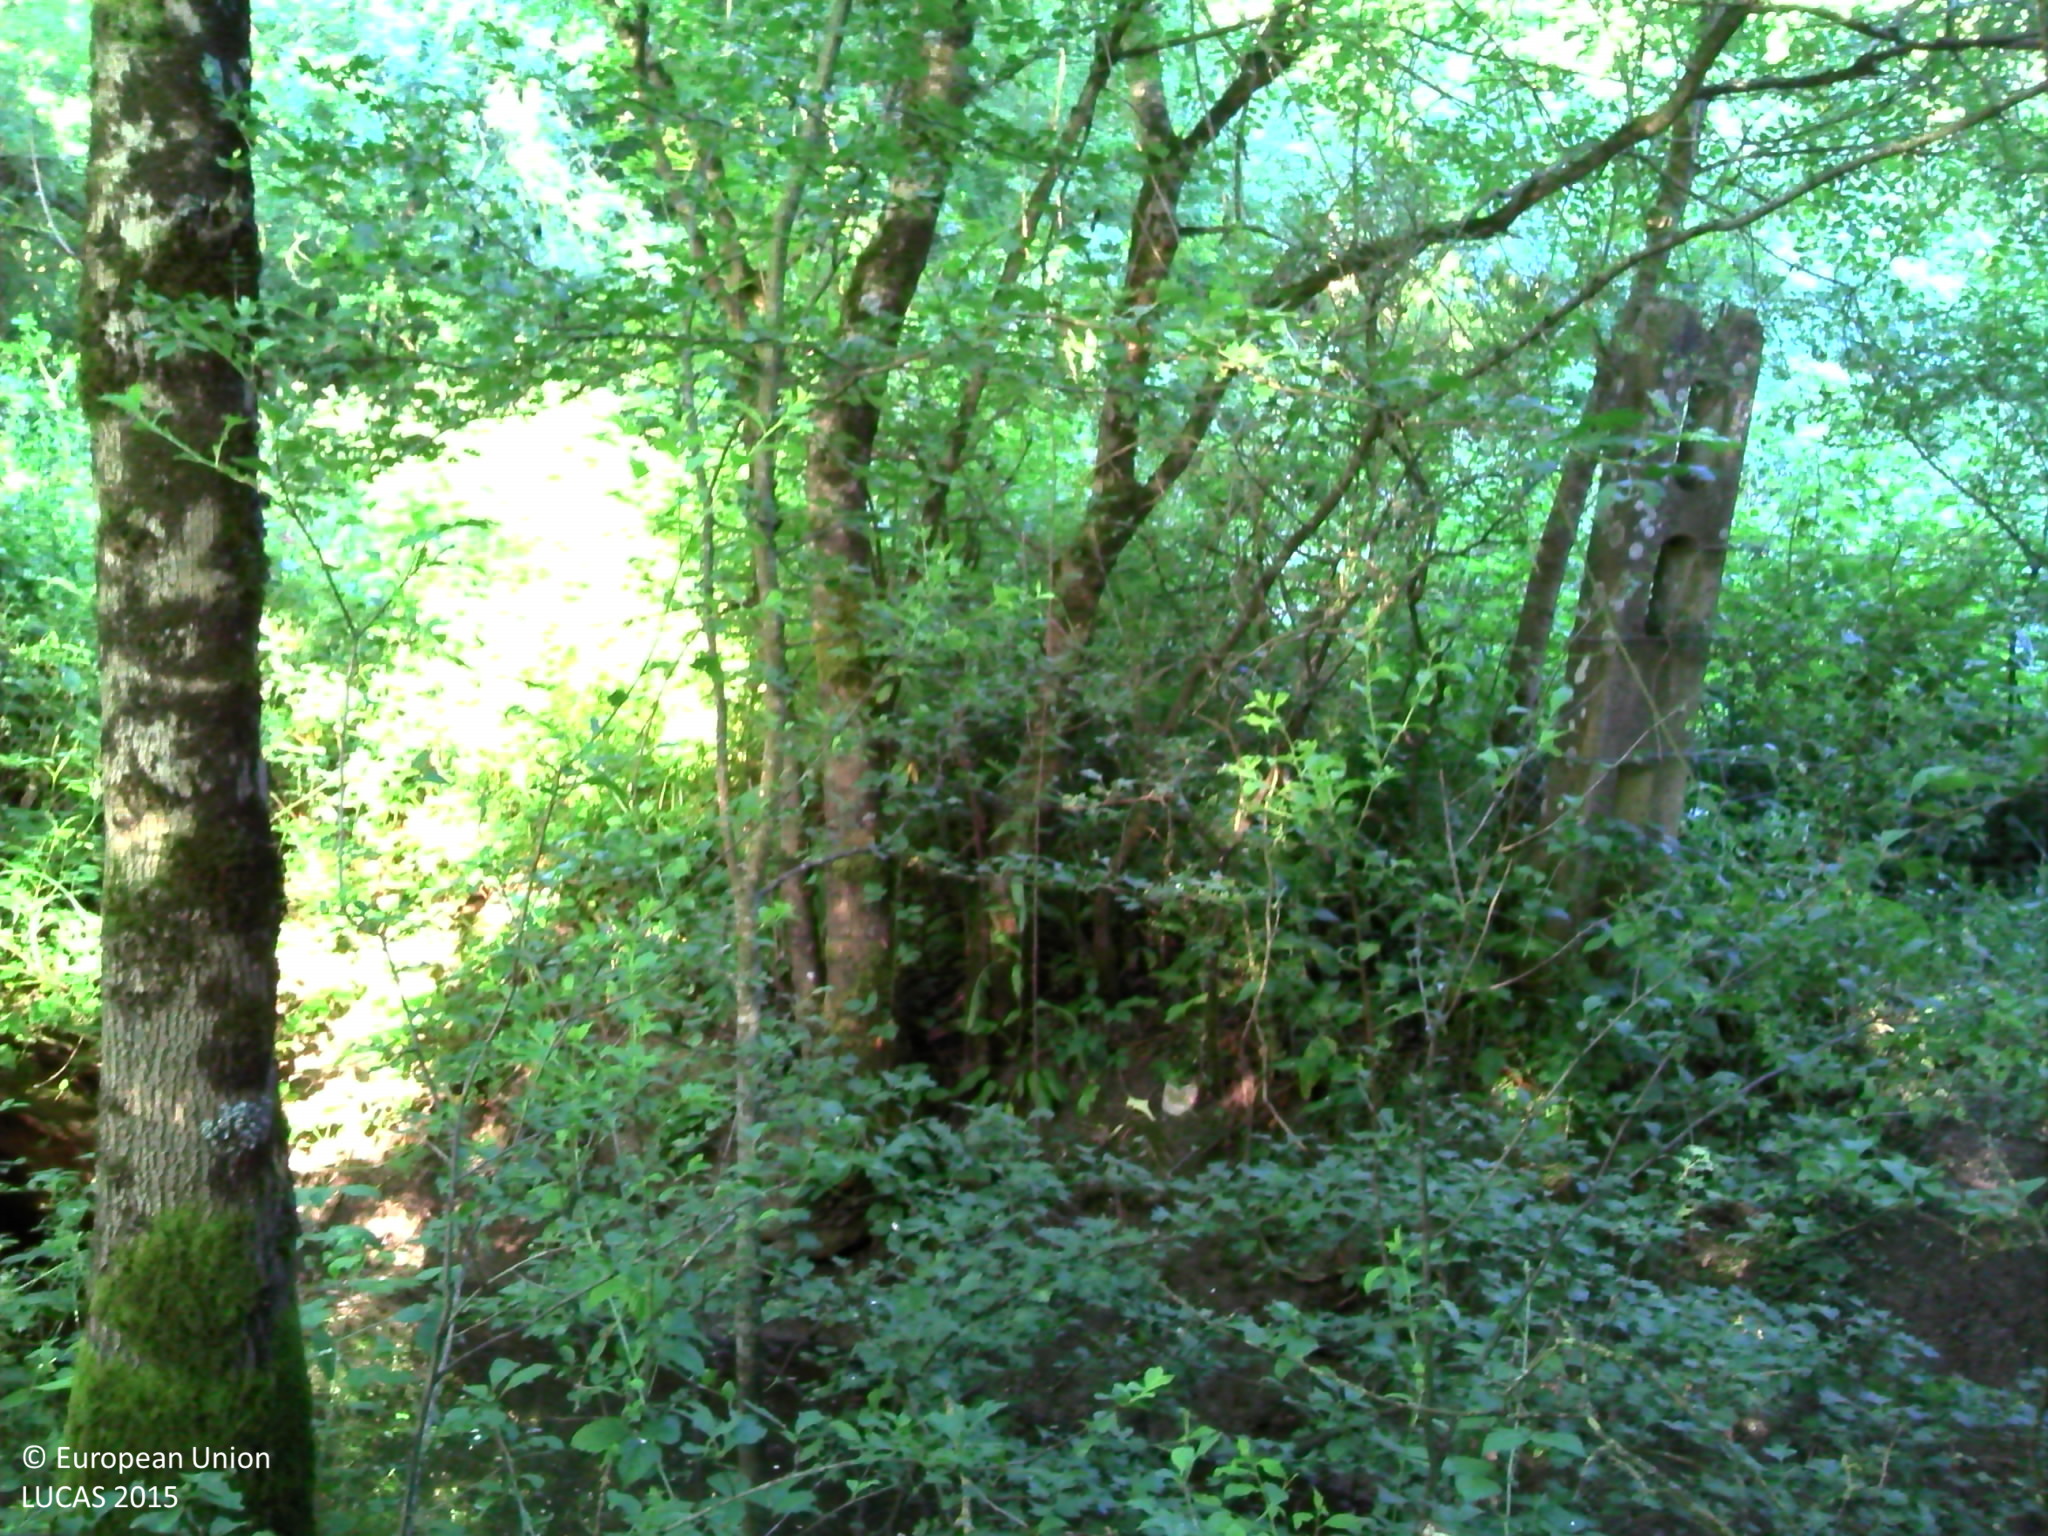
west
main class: Woodland
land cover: Broadleaved woodland
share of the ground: > 75 %
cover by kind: broadleaved forest trees 95 %, herbaceous plants 5 %
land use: Semi-natural and natural areas not in use
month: June
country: FR
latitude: 47.2234
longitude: -1.4644
